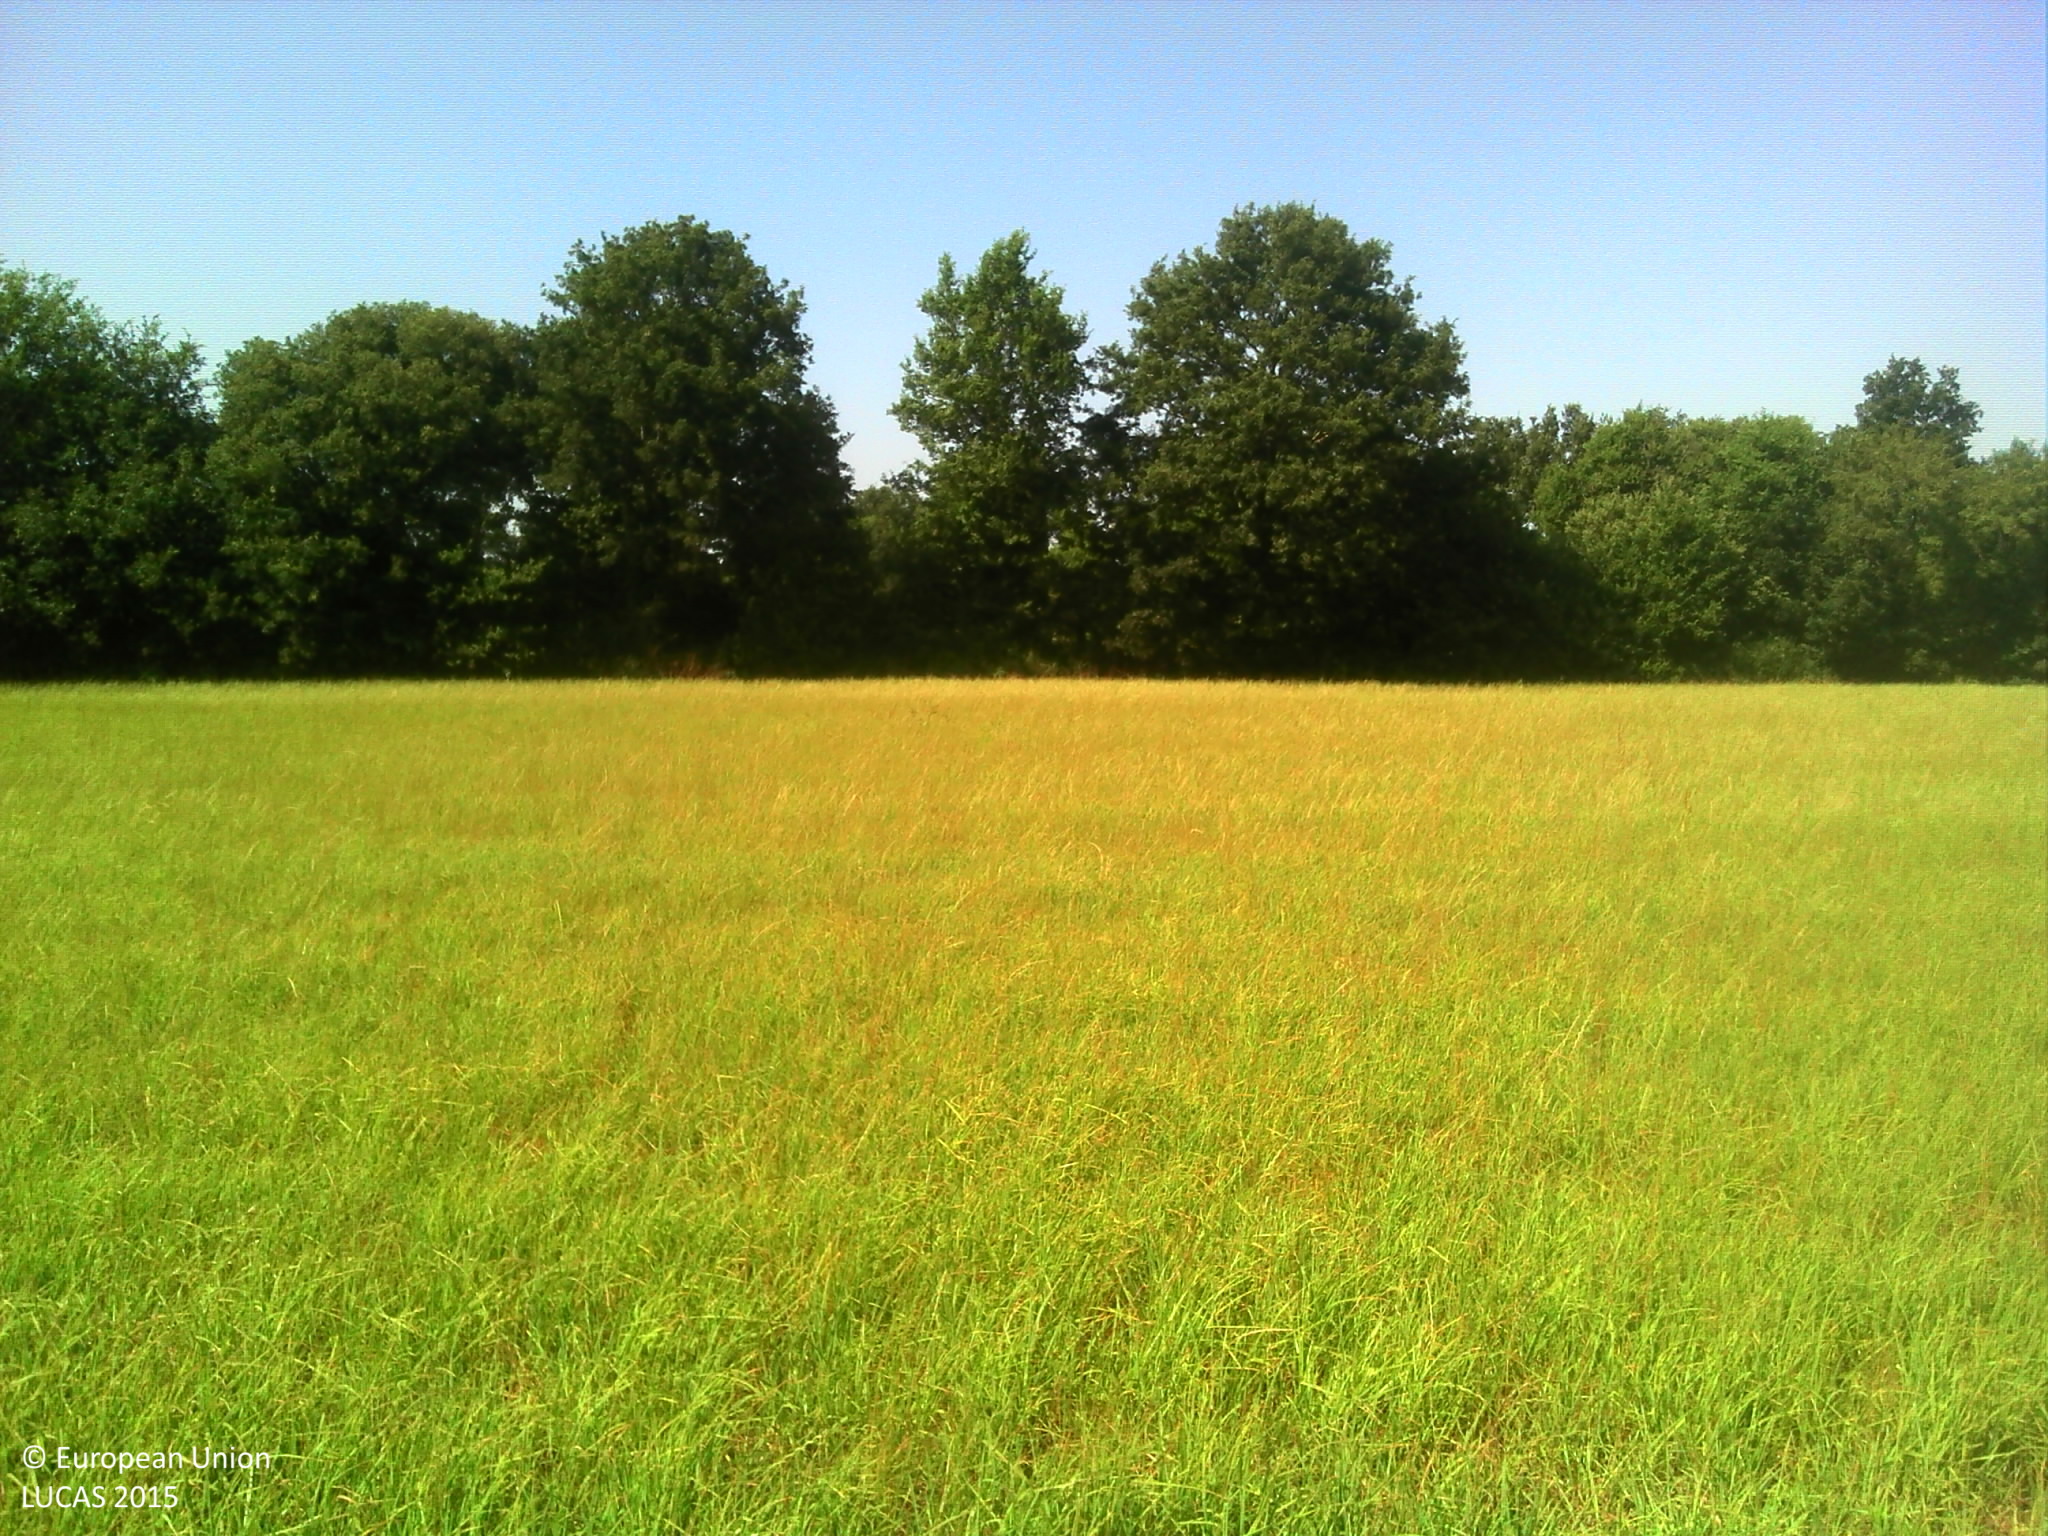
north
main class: Cropland
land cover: Temporary grasslands
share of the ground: > 75 %
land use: Agriculture (excluding fallow land and kitchen gardens)
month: July
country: FR
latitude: 46.5450
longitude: -1.6860
